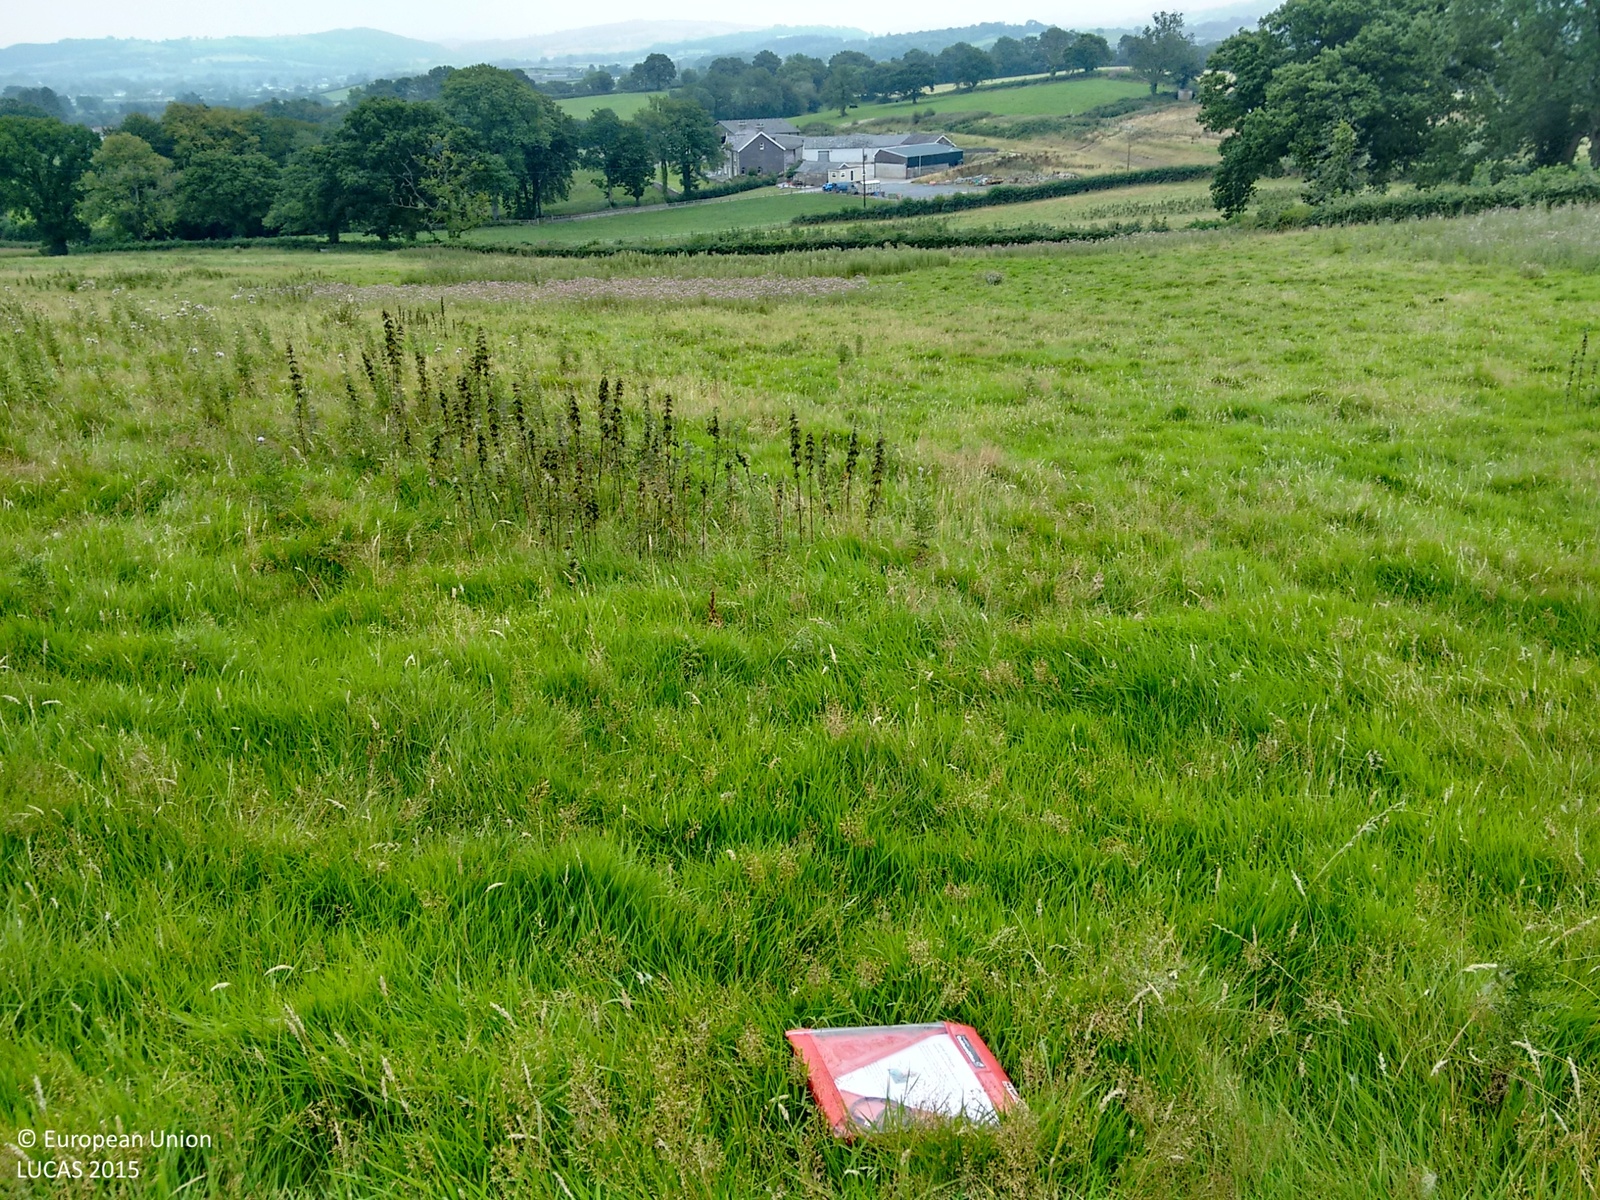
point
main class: Grassland
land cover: Grassland without tree/shrub cover
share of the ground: > 75 %
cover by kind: herbaceous plants 100 %
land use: Agriculture (excluding fallow land and kitchen gardens)
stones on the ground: < 10 %
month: August
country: GB
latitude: 51.9205
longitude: -3.8908
